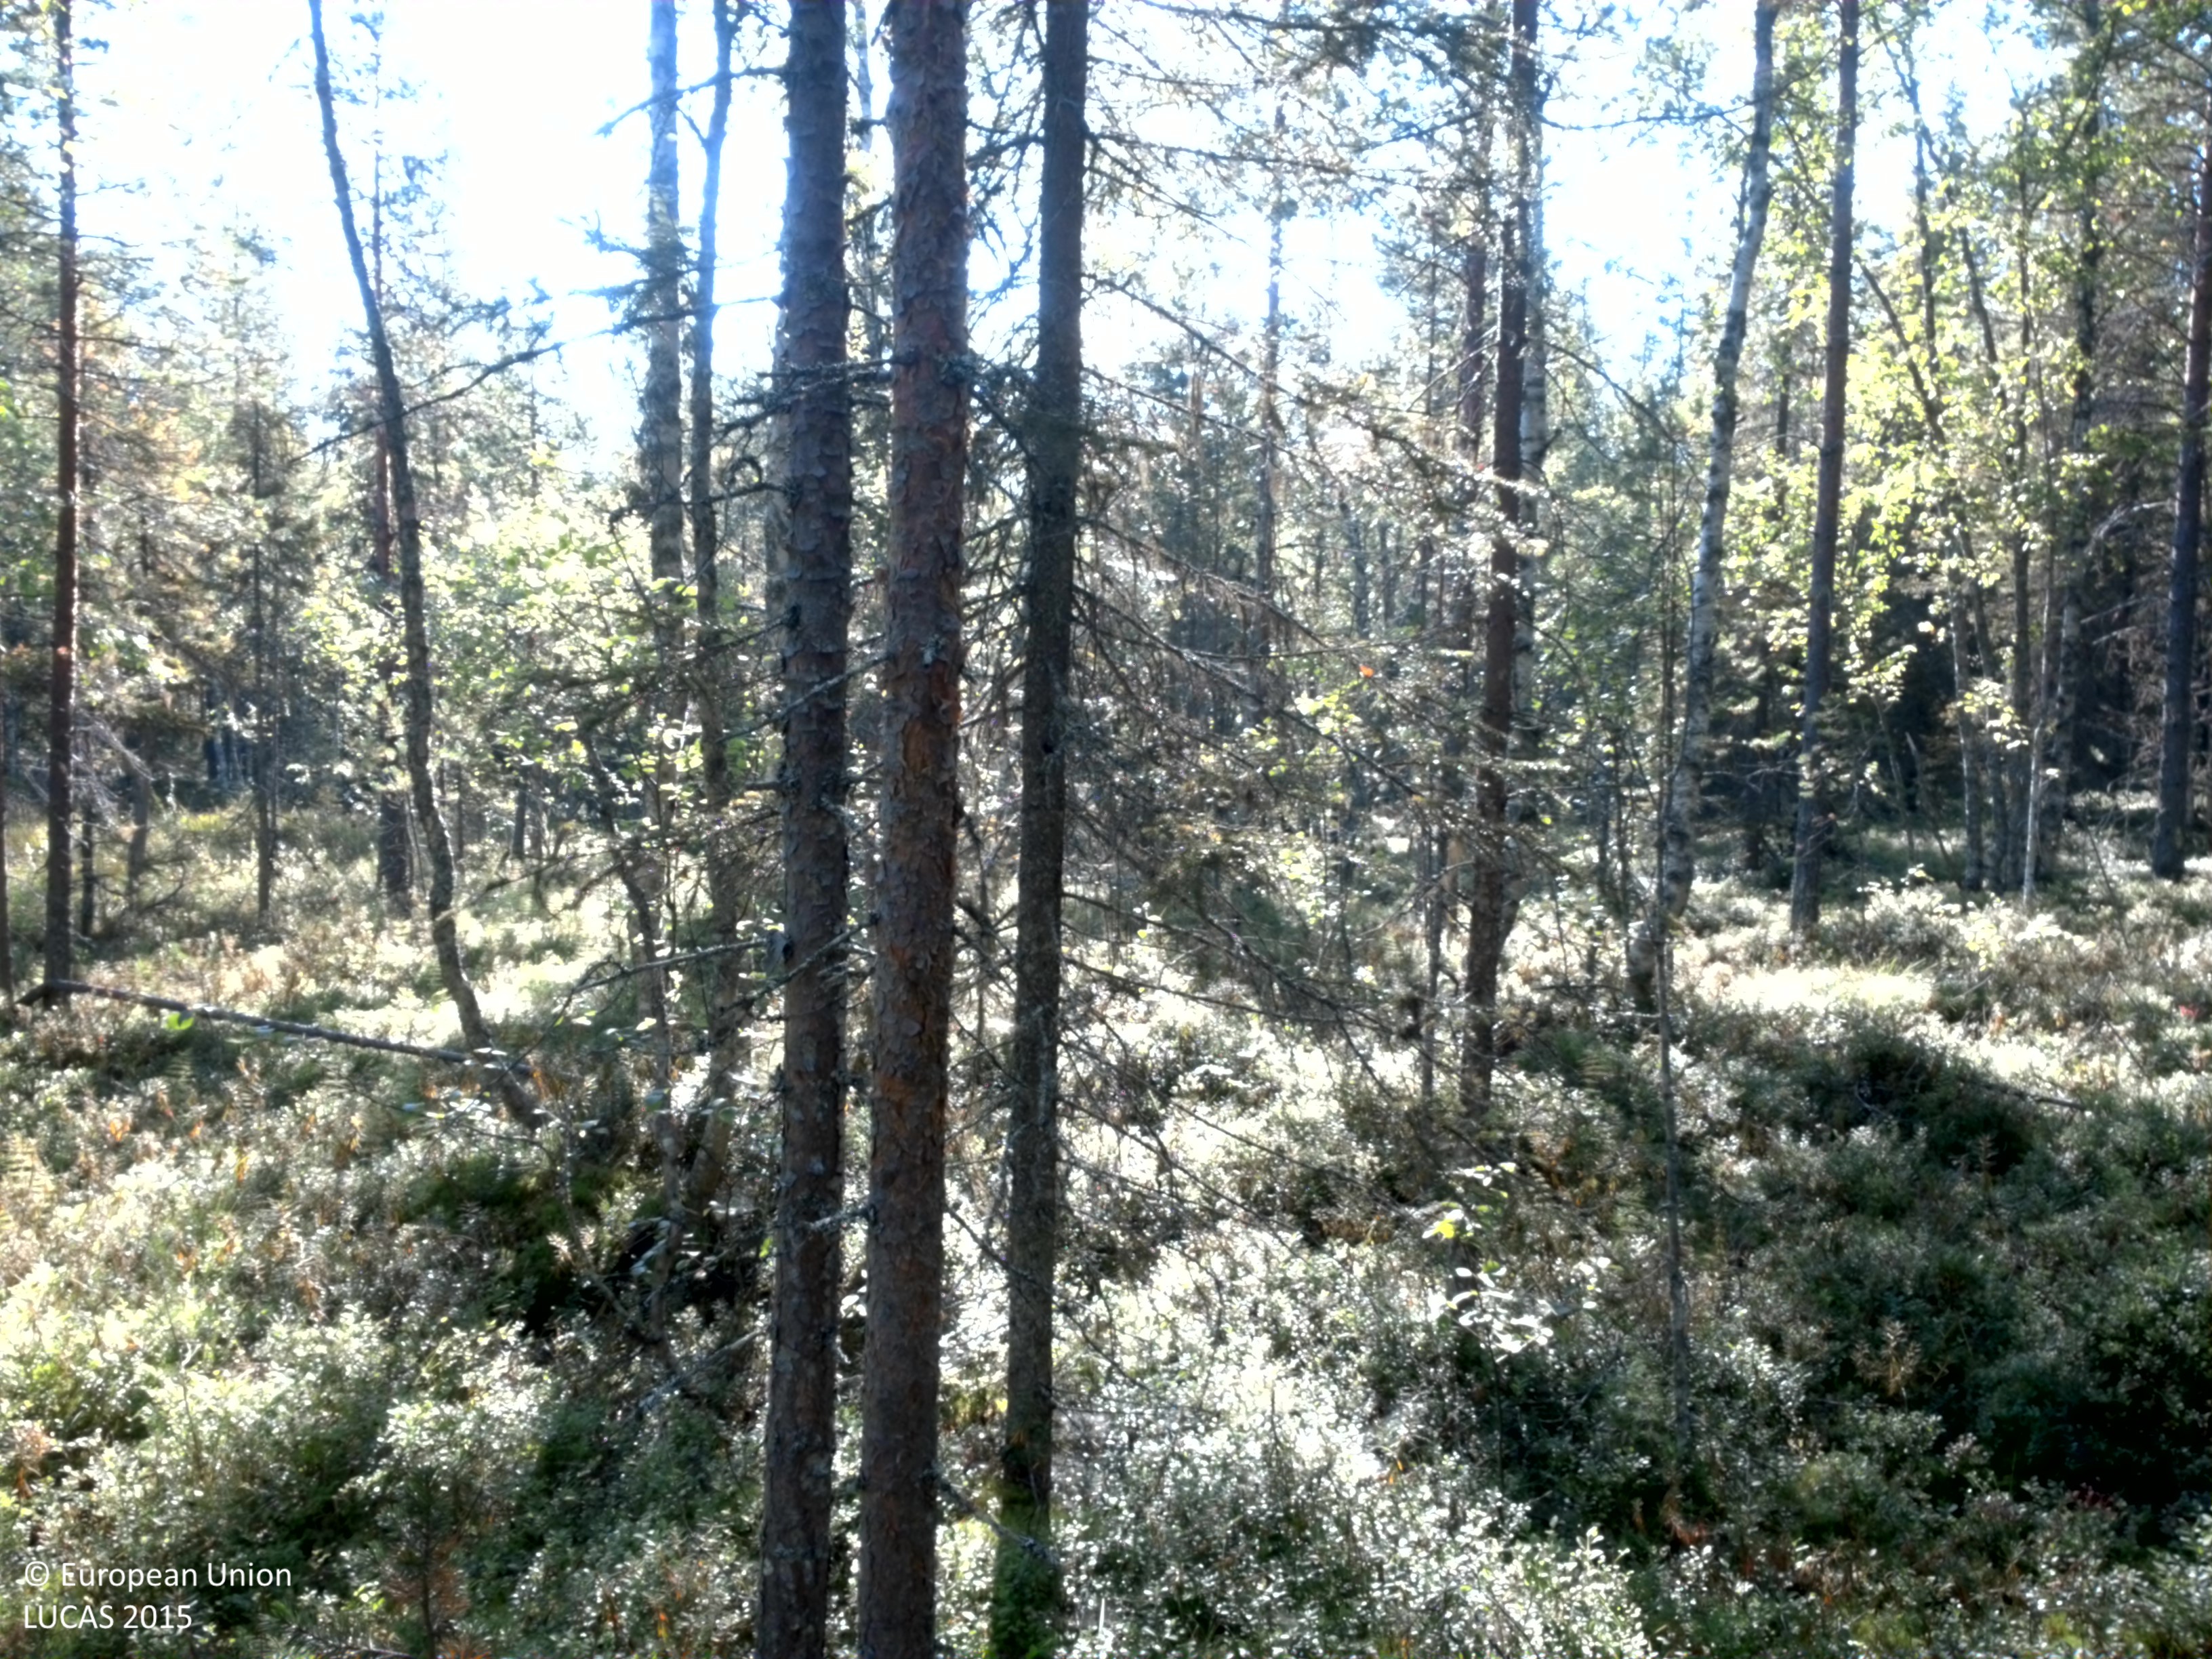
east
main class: Woodland
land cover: Pine dominated mixed woodland
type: boreal forest
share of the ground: 50 - 75 %
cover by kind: coniferous forest trees 45 %, shrubs 35 %, broadleaved forest trees 15 %, lichens and mosses 5 %
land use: Forestry
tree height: > 5 m
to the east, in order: Pine dominated mixed woodland; Pine dominated coniferous woodland; Peatbogs; Pine dominated coniferous woodland; Rivers and streams; Pine dominated coniferous woodland; Pine dominated mixed woodland
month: August
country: SE
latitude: 64.5497
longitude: 18.8746
